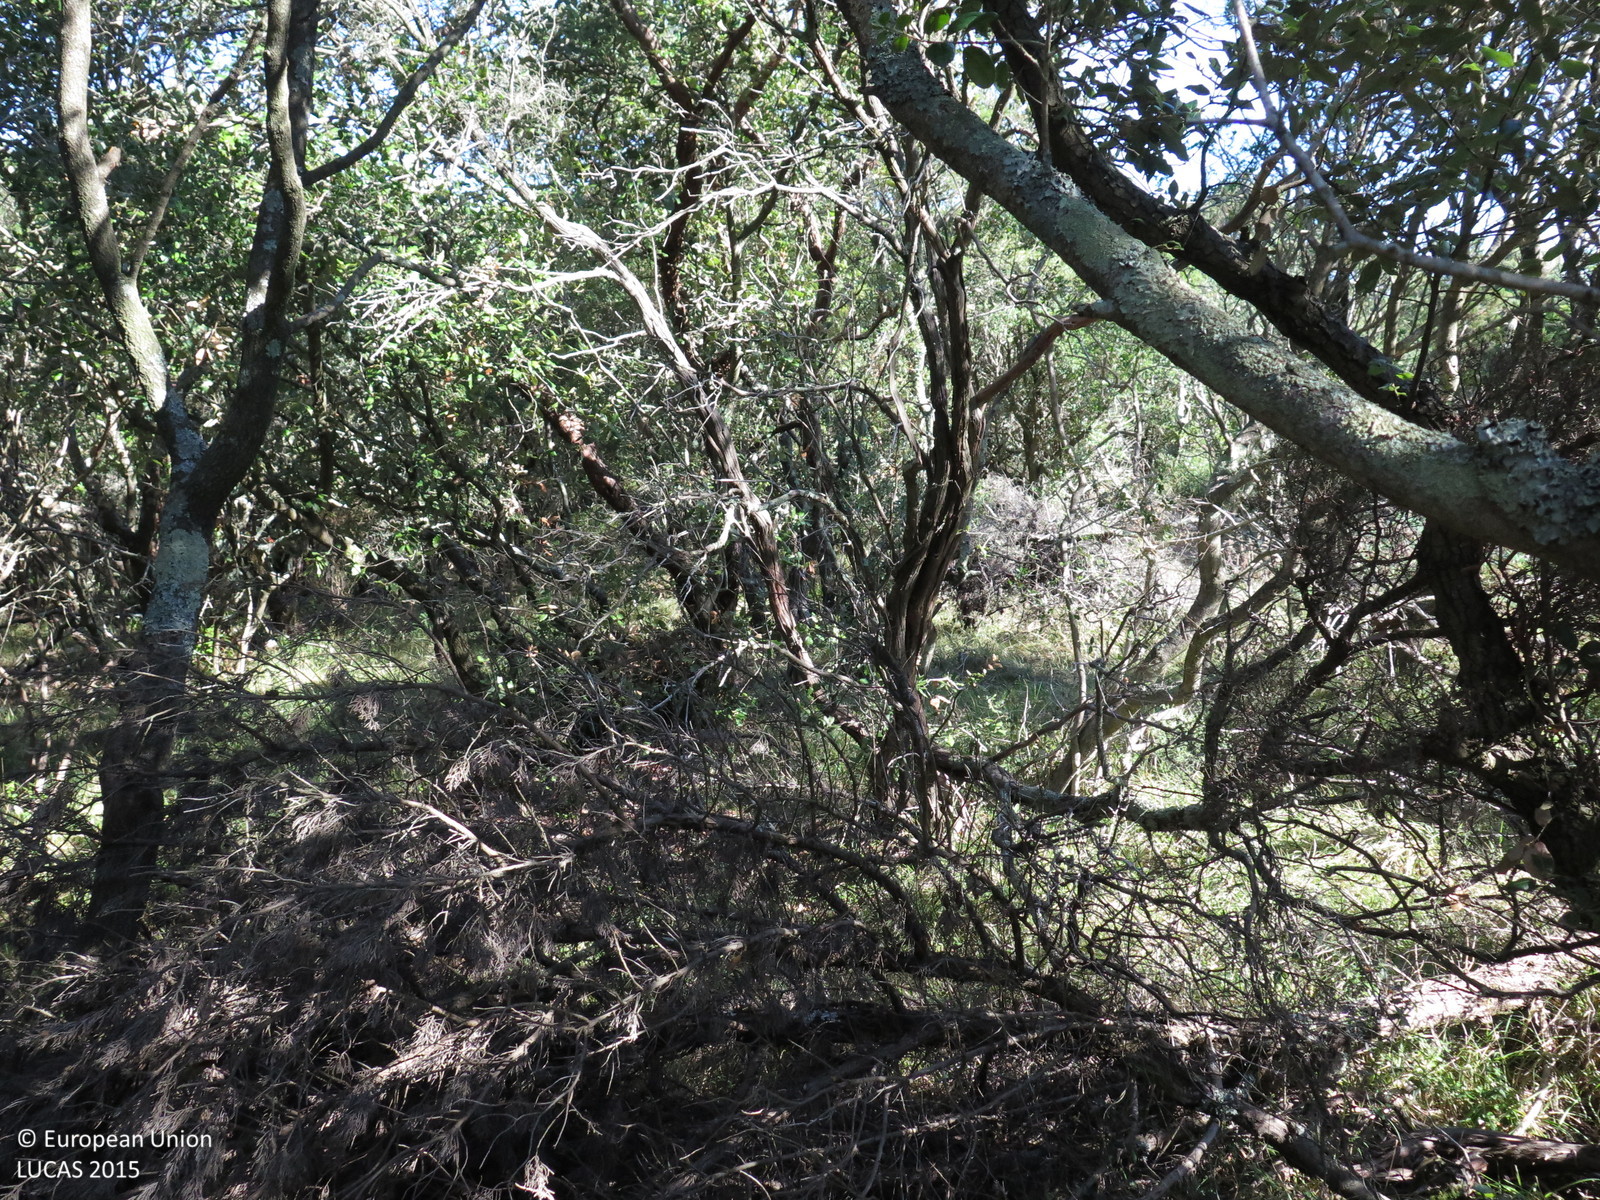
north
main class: Woodland
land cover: Broadleaved woodland
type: thermophilous deciduous forest
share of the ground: > 75 %
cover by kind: broadleaved forest trees 90 %, shrubs 5 %, herbaceous plants 5 %
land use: Semi-natural and natural areas not in use
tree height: > 5 m
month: September
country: HR
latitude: 44.5828
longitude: 14.3888
